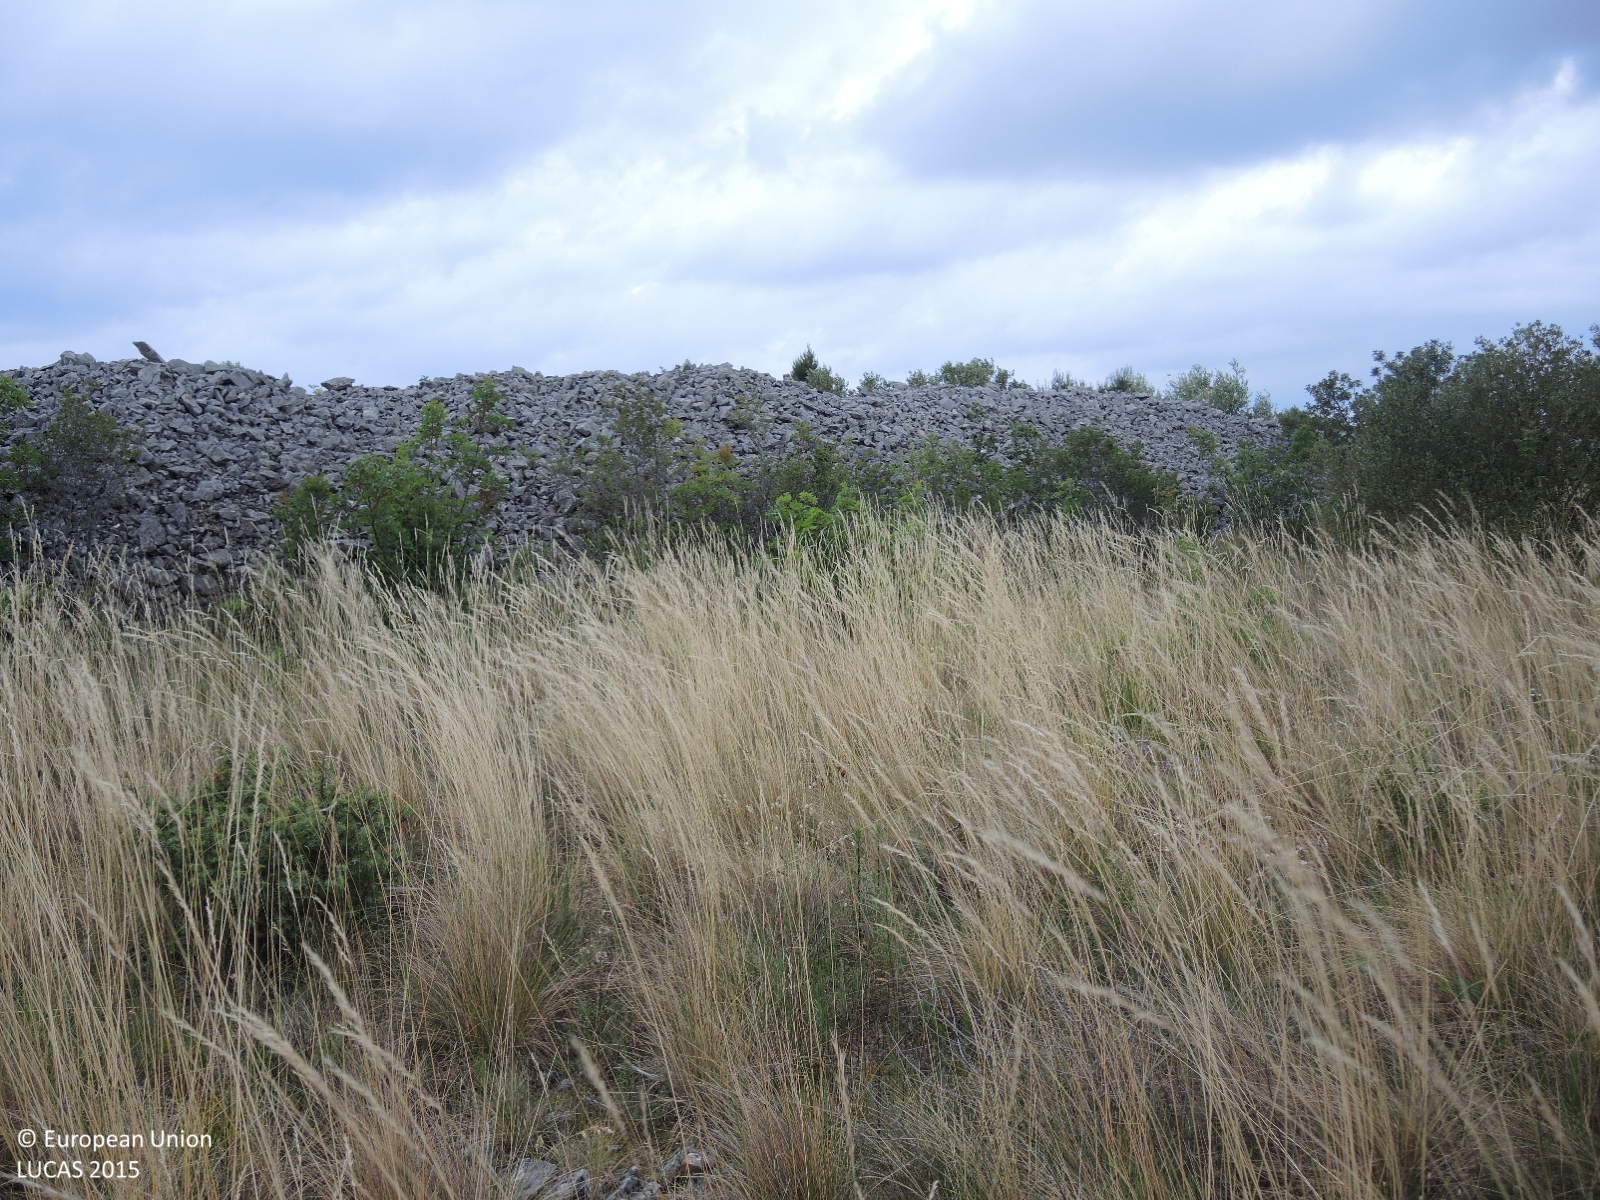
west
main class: Cropland
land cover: Olive groves
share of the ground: 10 - 25 %
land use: Agriculture (excluding fallow land and kitchen gardens)
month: May
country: HR
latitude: 43.7535
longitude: 15.8158
